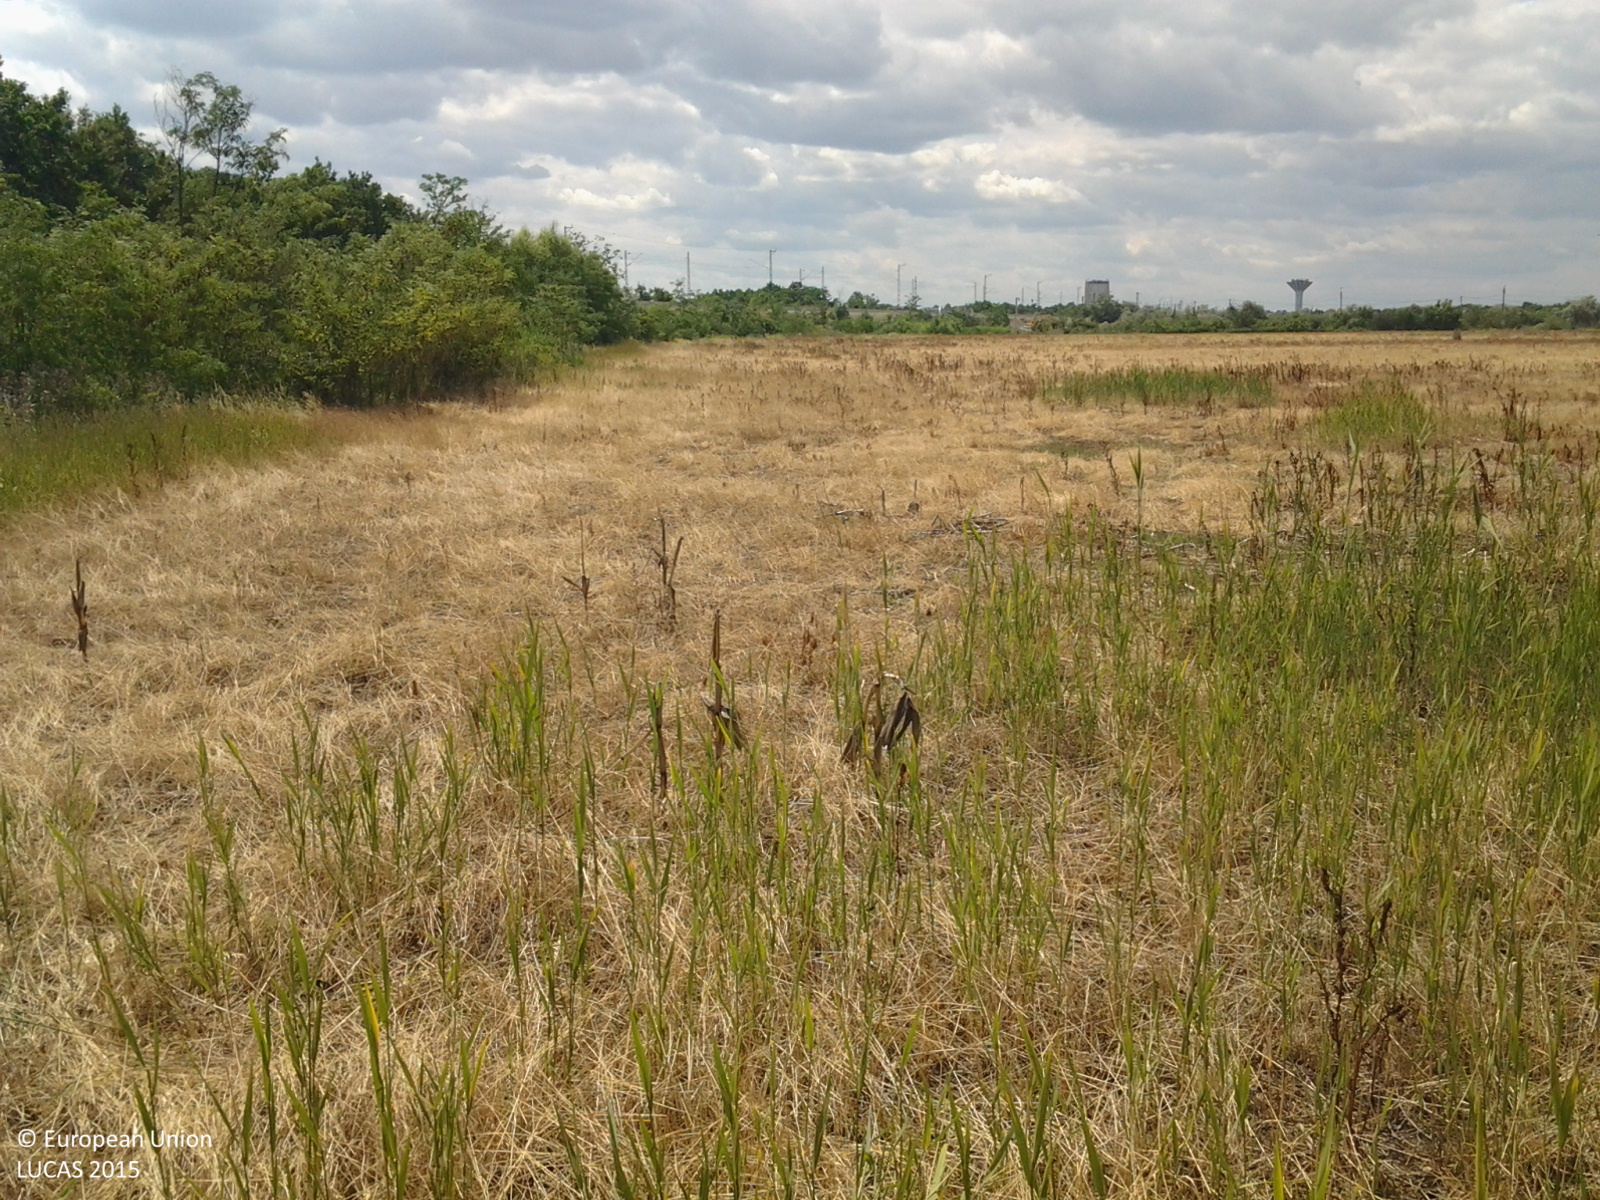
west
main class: Grassland
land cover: Grassland without tree/shrub cover
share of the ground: > 75 %
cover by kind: herbaceous plants 90 %, unconsolidated bare surface 10 %
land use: Abandoned areas
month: June
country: HU
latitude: 47.1843
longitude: 20.2278
